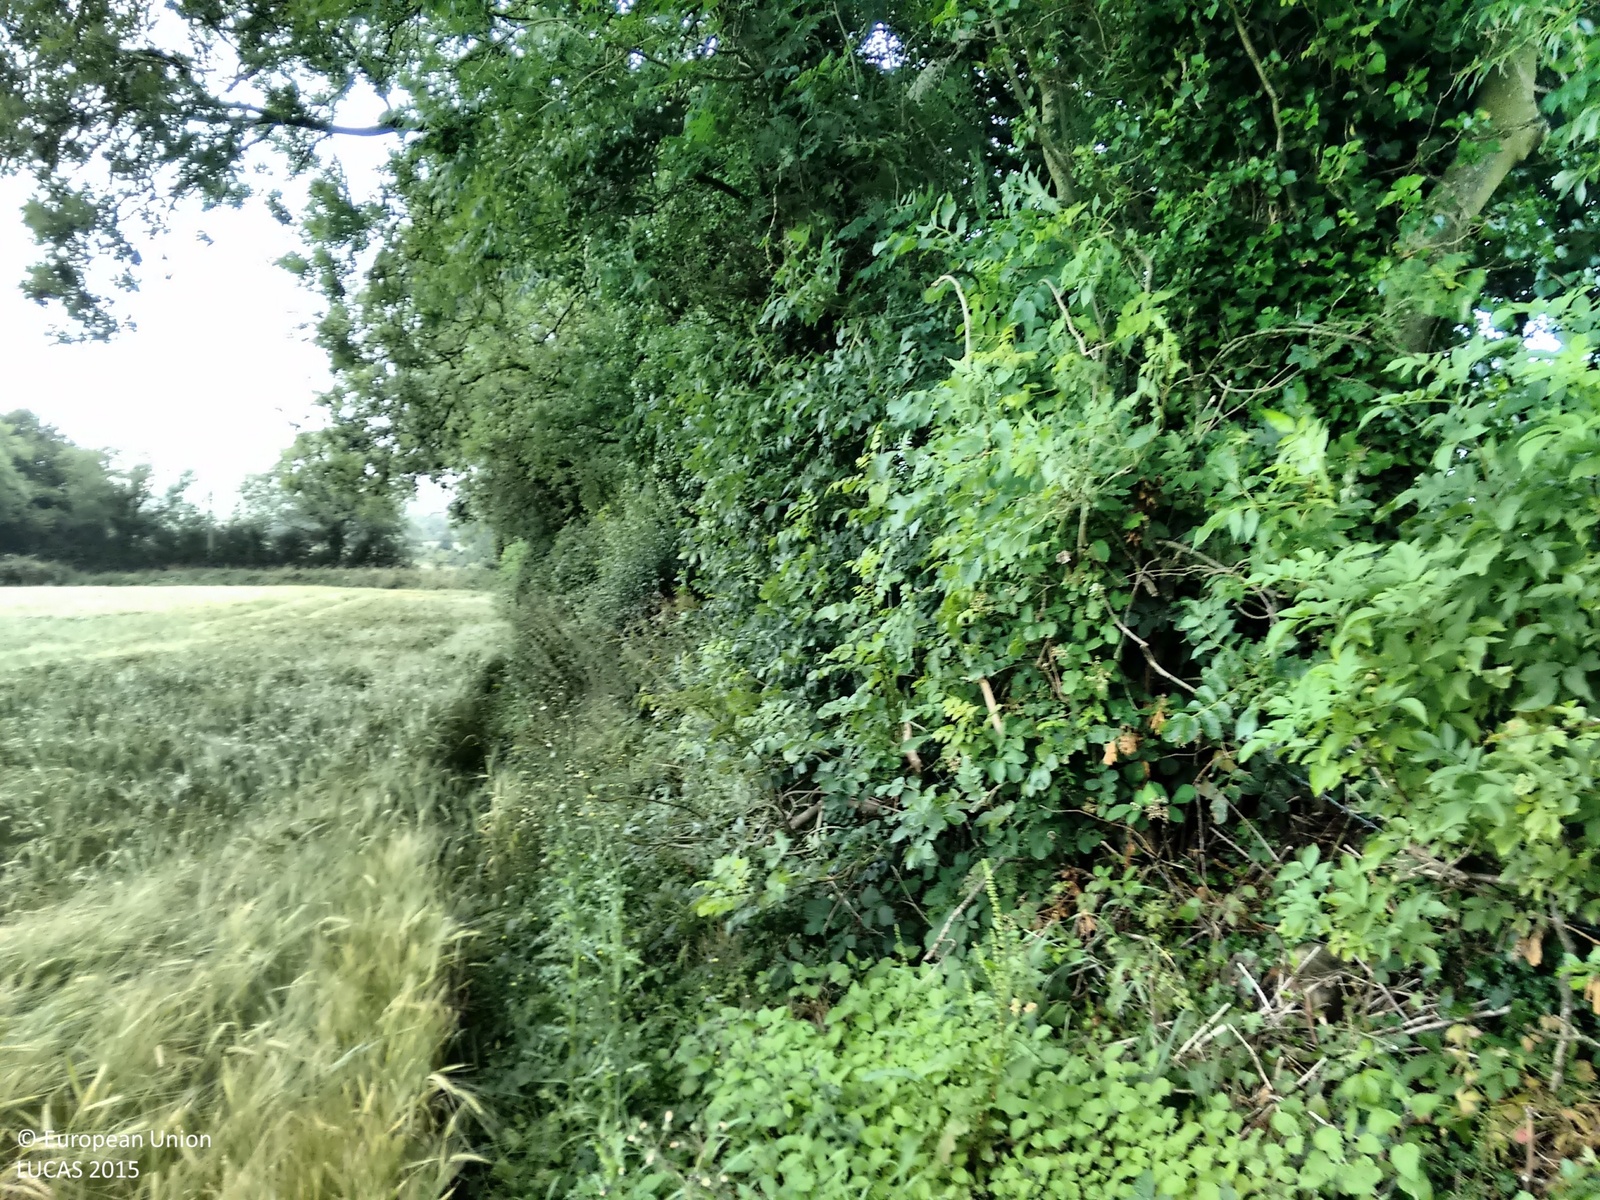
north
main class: Cropland
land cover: Barley
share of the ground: > 75 %
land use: Agriculture (excluding fallow land and kitchen gardens)
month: August
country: IE
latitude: 52.7064
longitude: -6.4509
